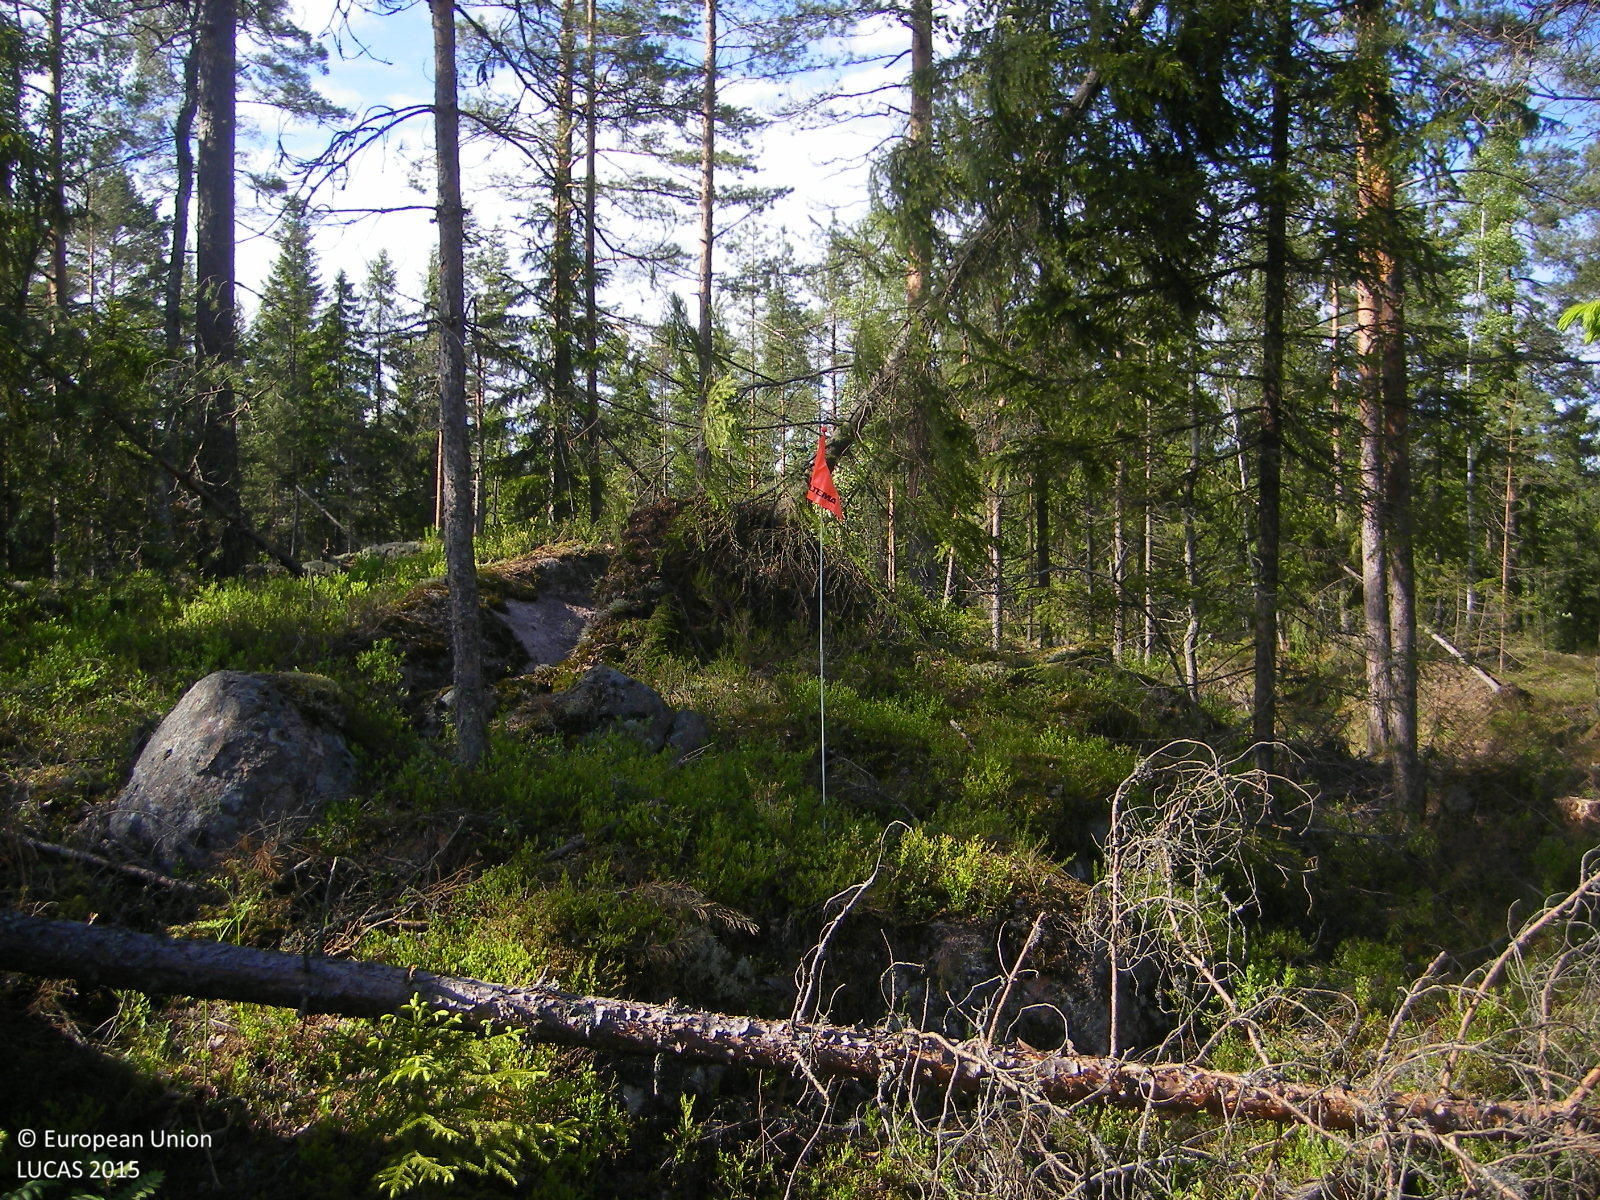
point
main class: Woodland
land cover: Pine dominated coniferous woodland
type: boreal forest
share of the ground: 10 - 25 %
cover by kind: shrubs 45 %, unconsolidated bare surface 35 %, coniferous forest trees 20 %
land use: Forestry
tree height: > 5 m
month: June
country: FI
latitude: 60.2397
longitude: 24.6136
